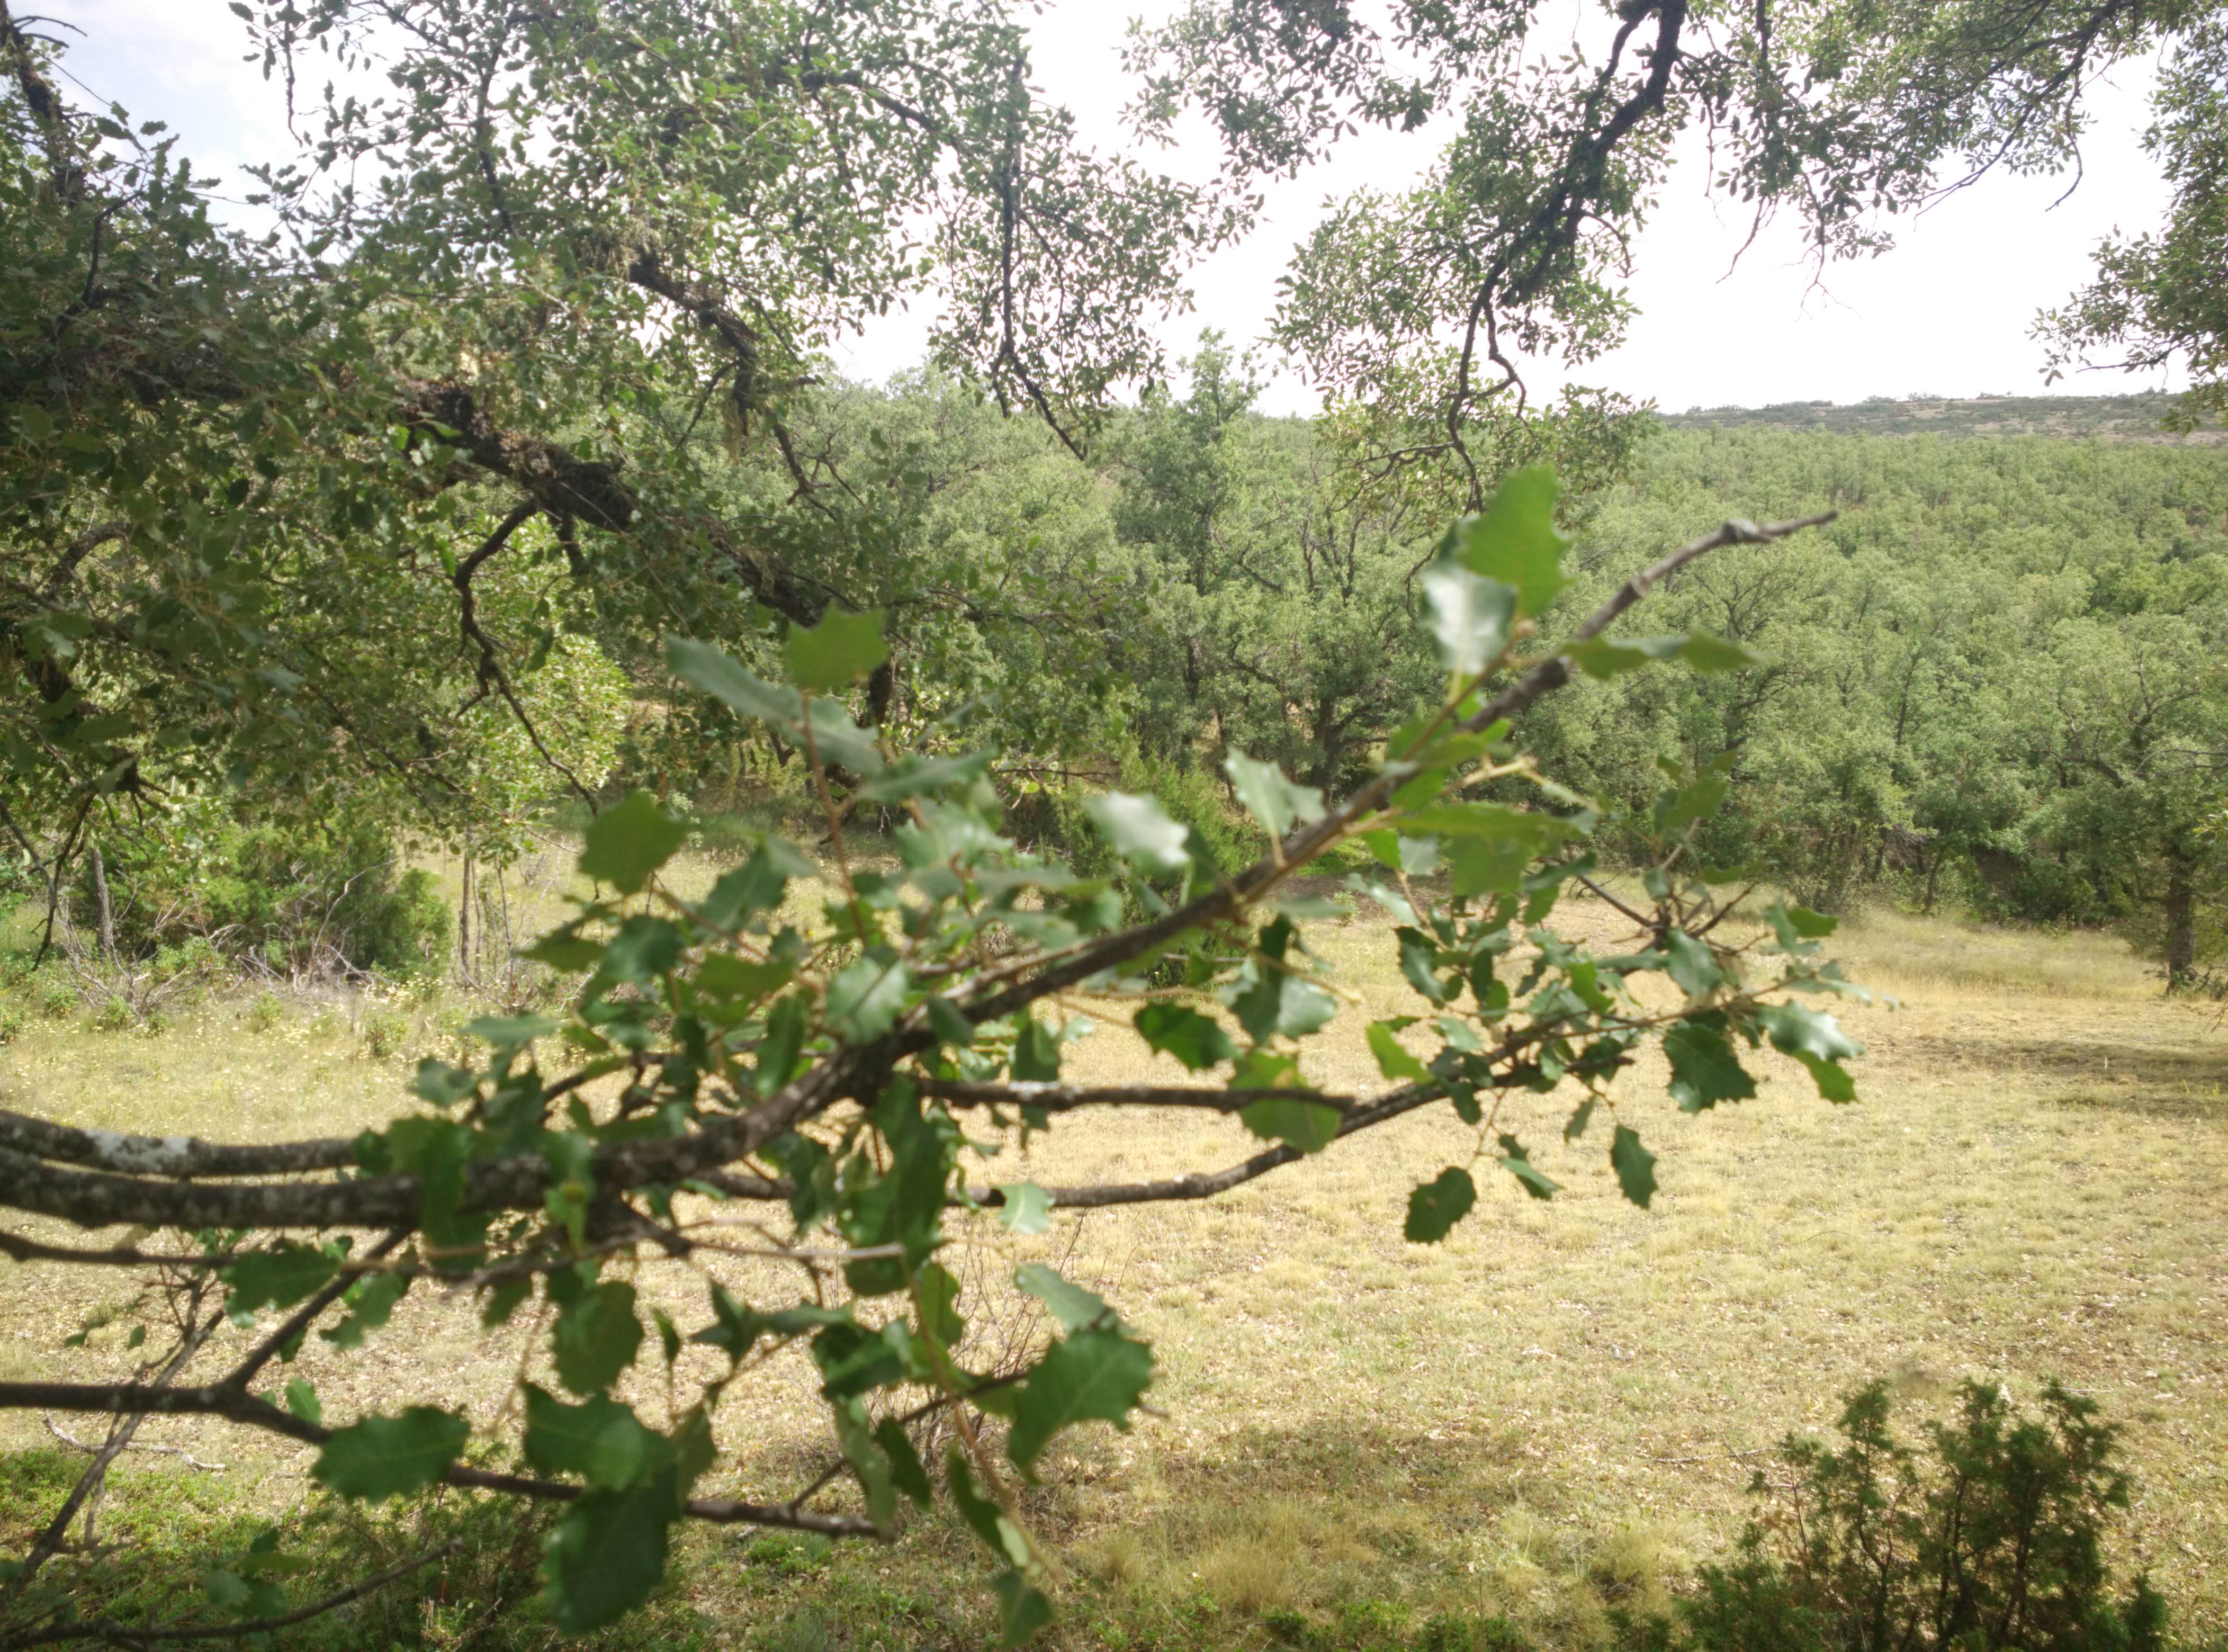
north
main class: Grassland
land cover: Grassland with sparse tree/shrub cover
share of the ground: 50 - 75 %
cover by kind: herbaceous plants 60 %, unconsolidated bare surface 30 %, broadleaved forest trees 5 %, shrubs 5 %
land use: Semi-natural and natural areas not in use
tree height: > 5 m
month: July
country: ES
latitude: 40.9362
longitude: -1.9843
